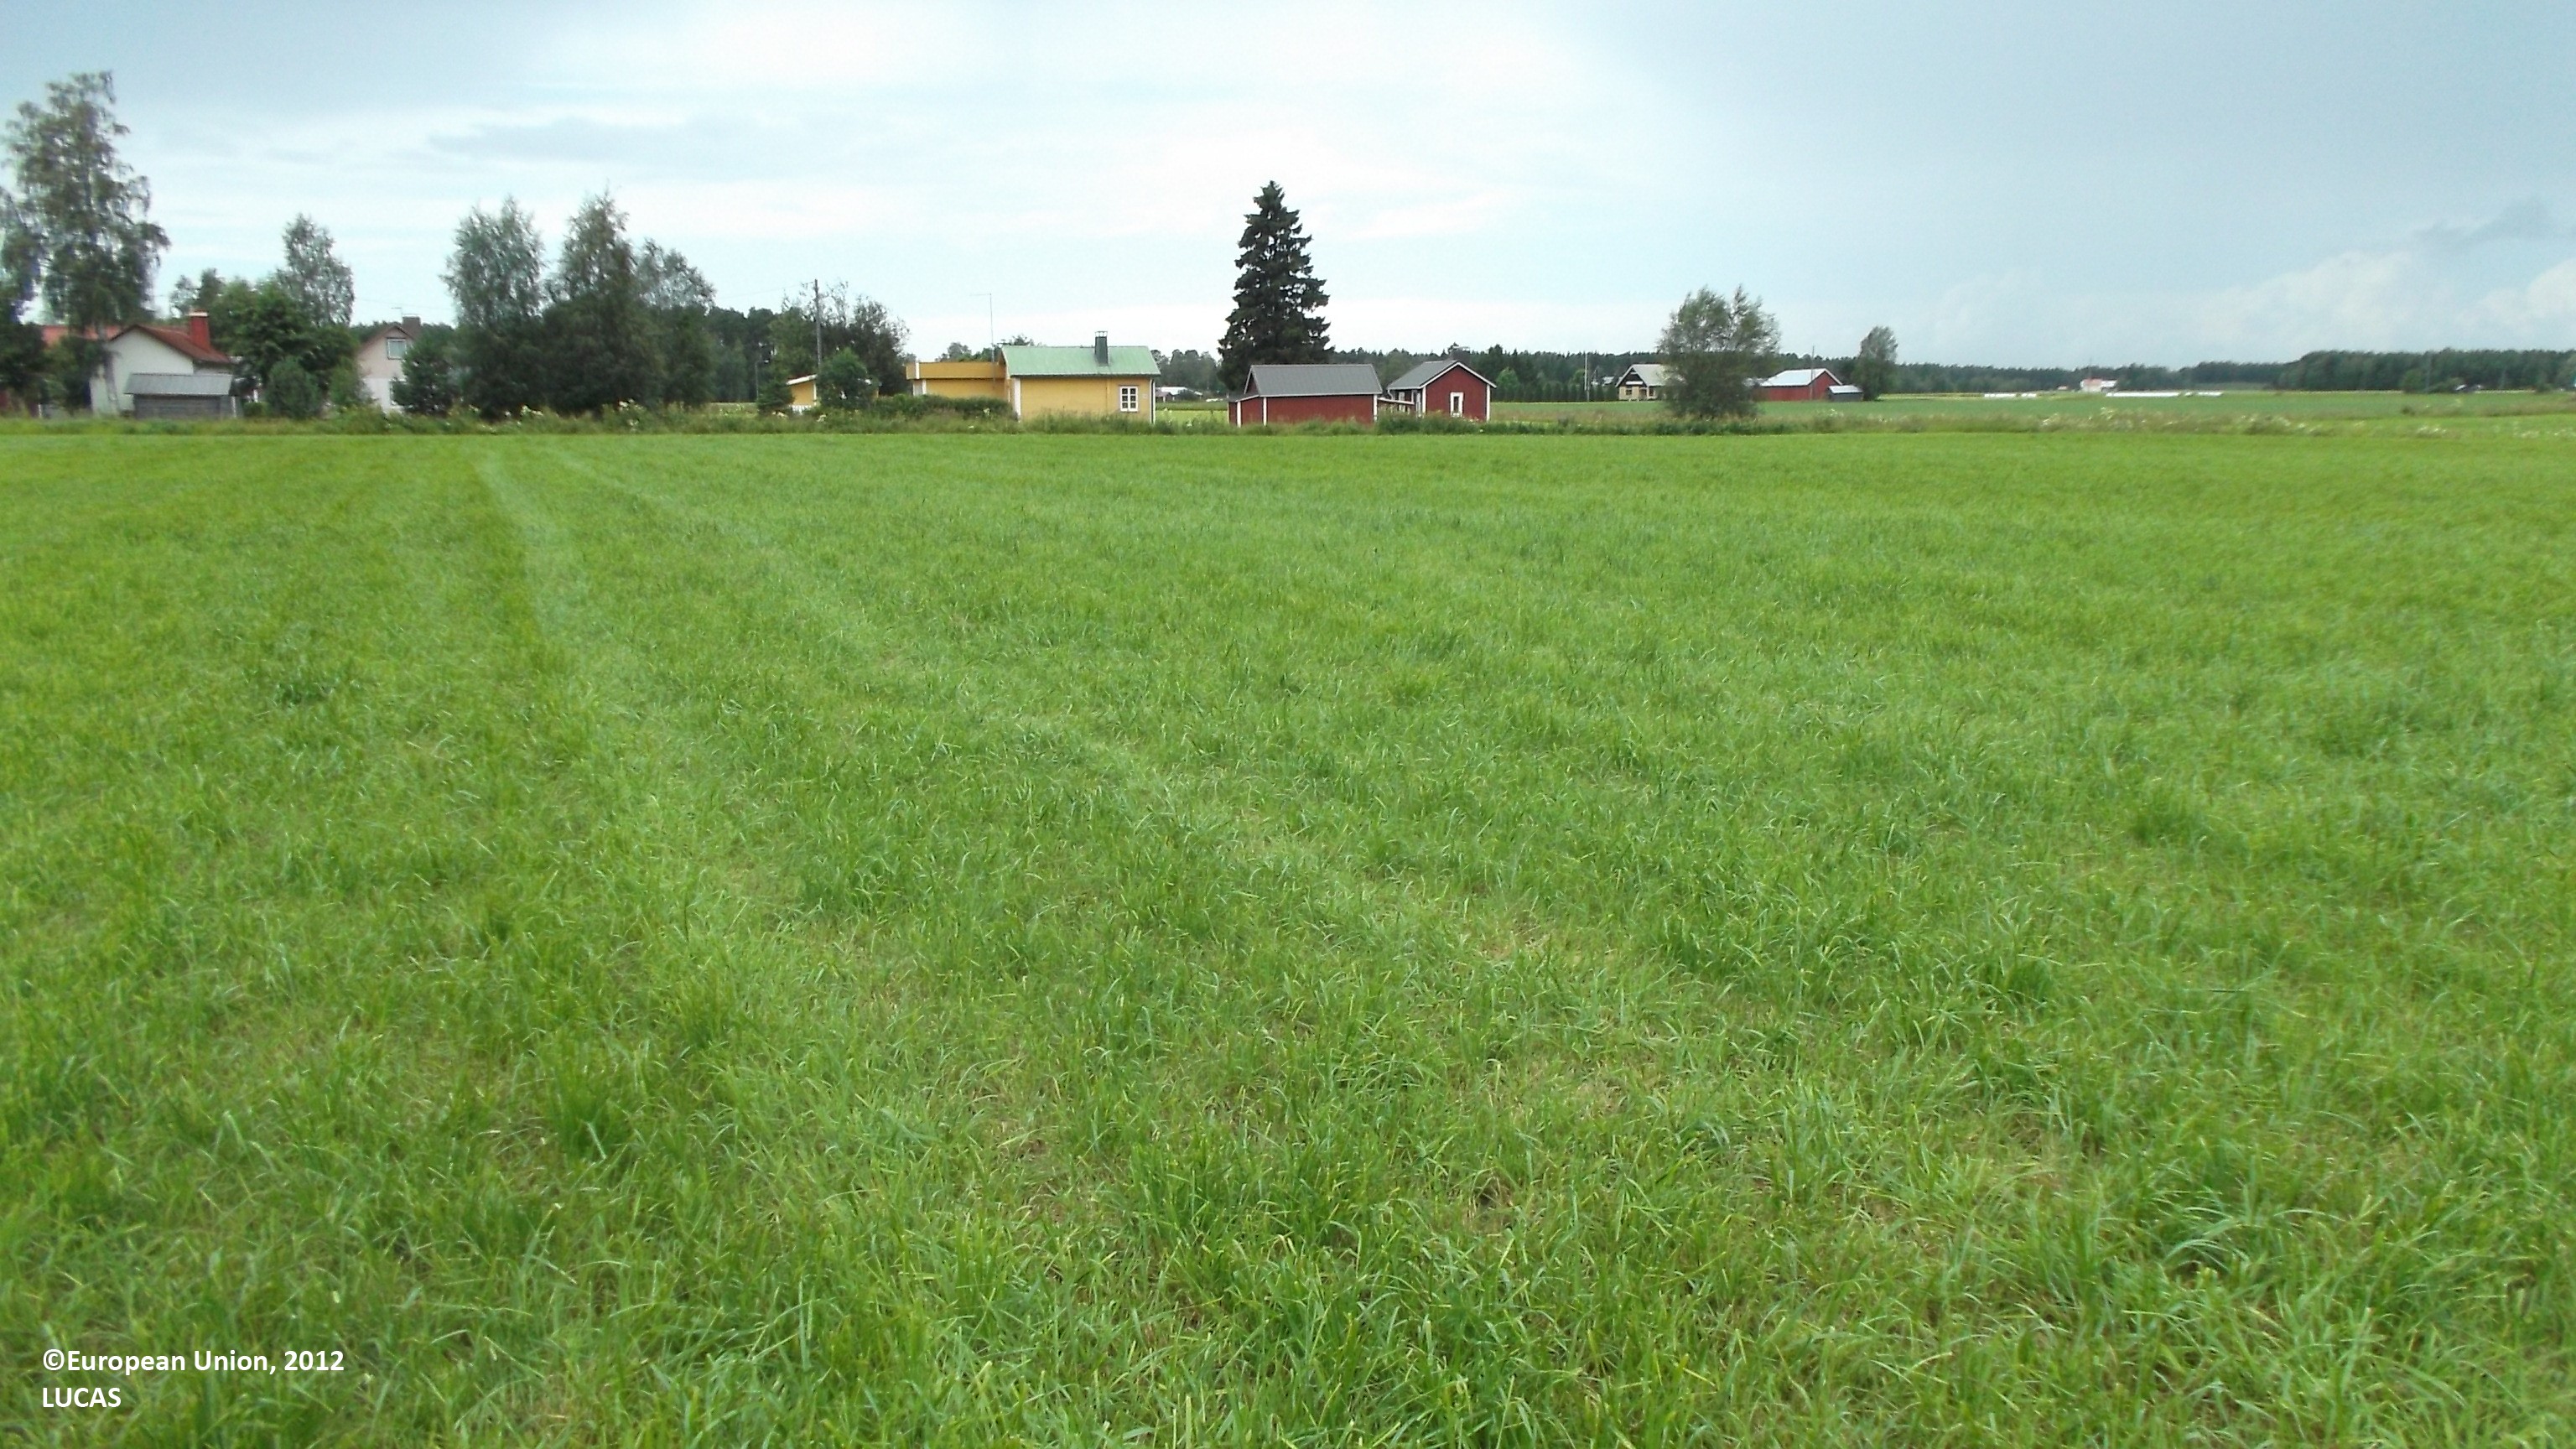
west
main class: Cropland
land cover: Temporary grasslands
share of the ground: > 75 %
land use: Agriculture (excluding fallow land and kitchen gardens)
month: August
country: FI
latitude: 64.0379
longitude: 23.5079
